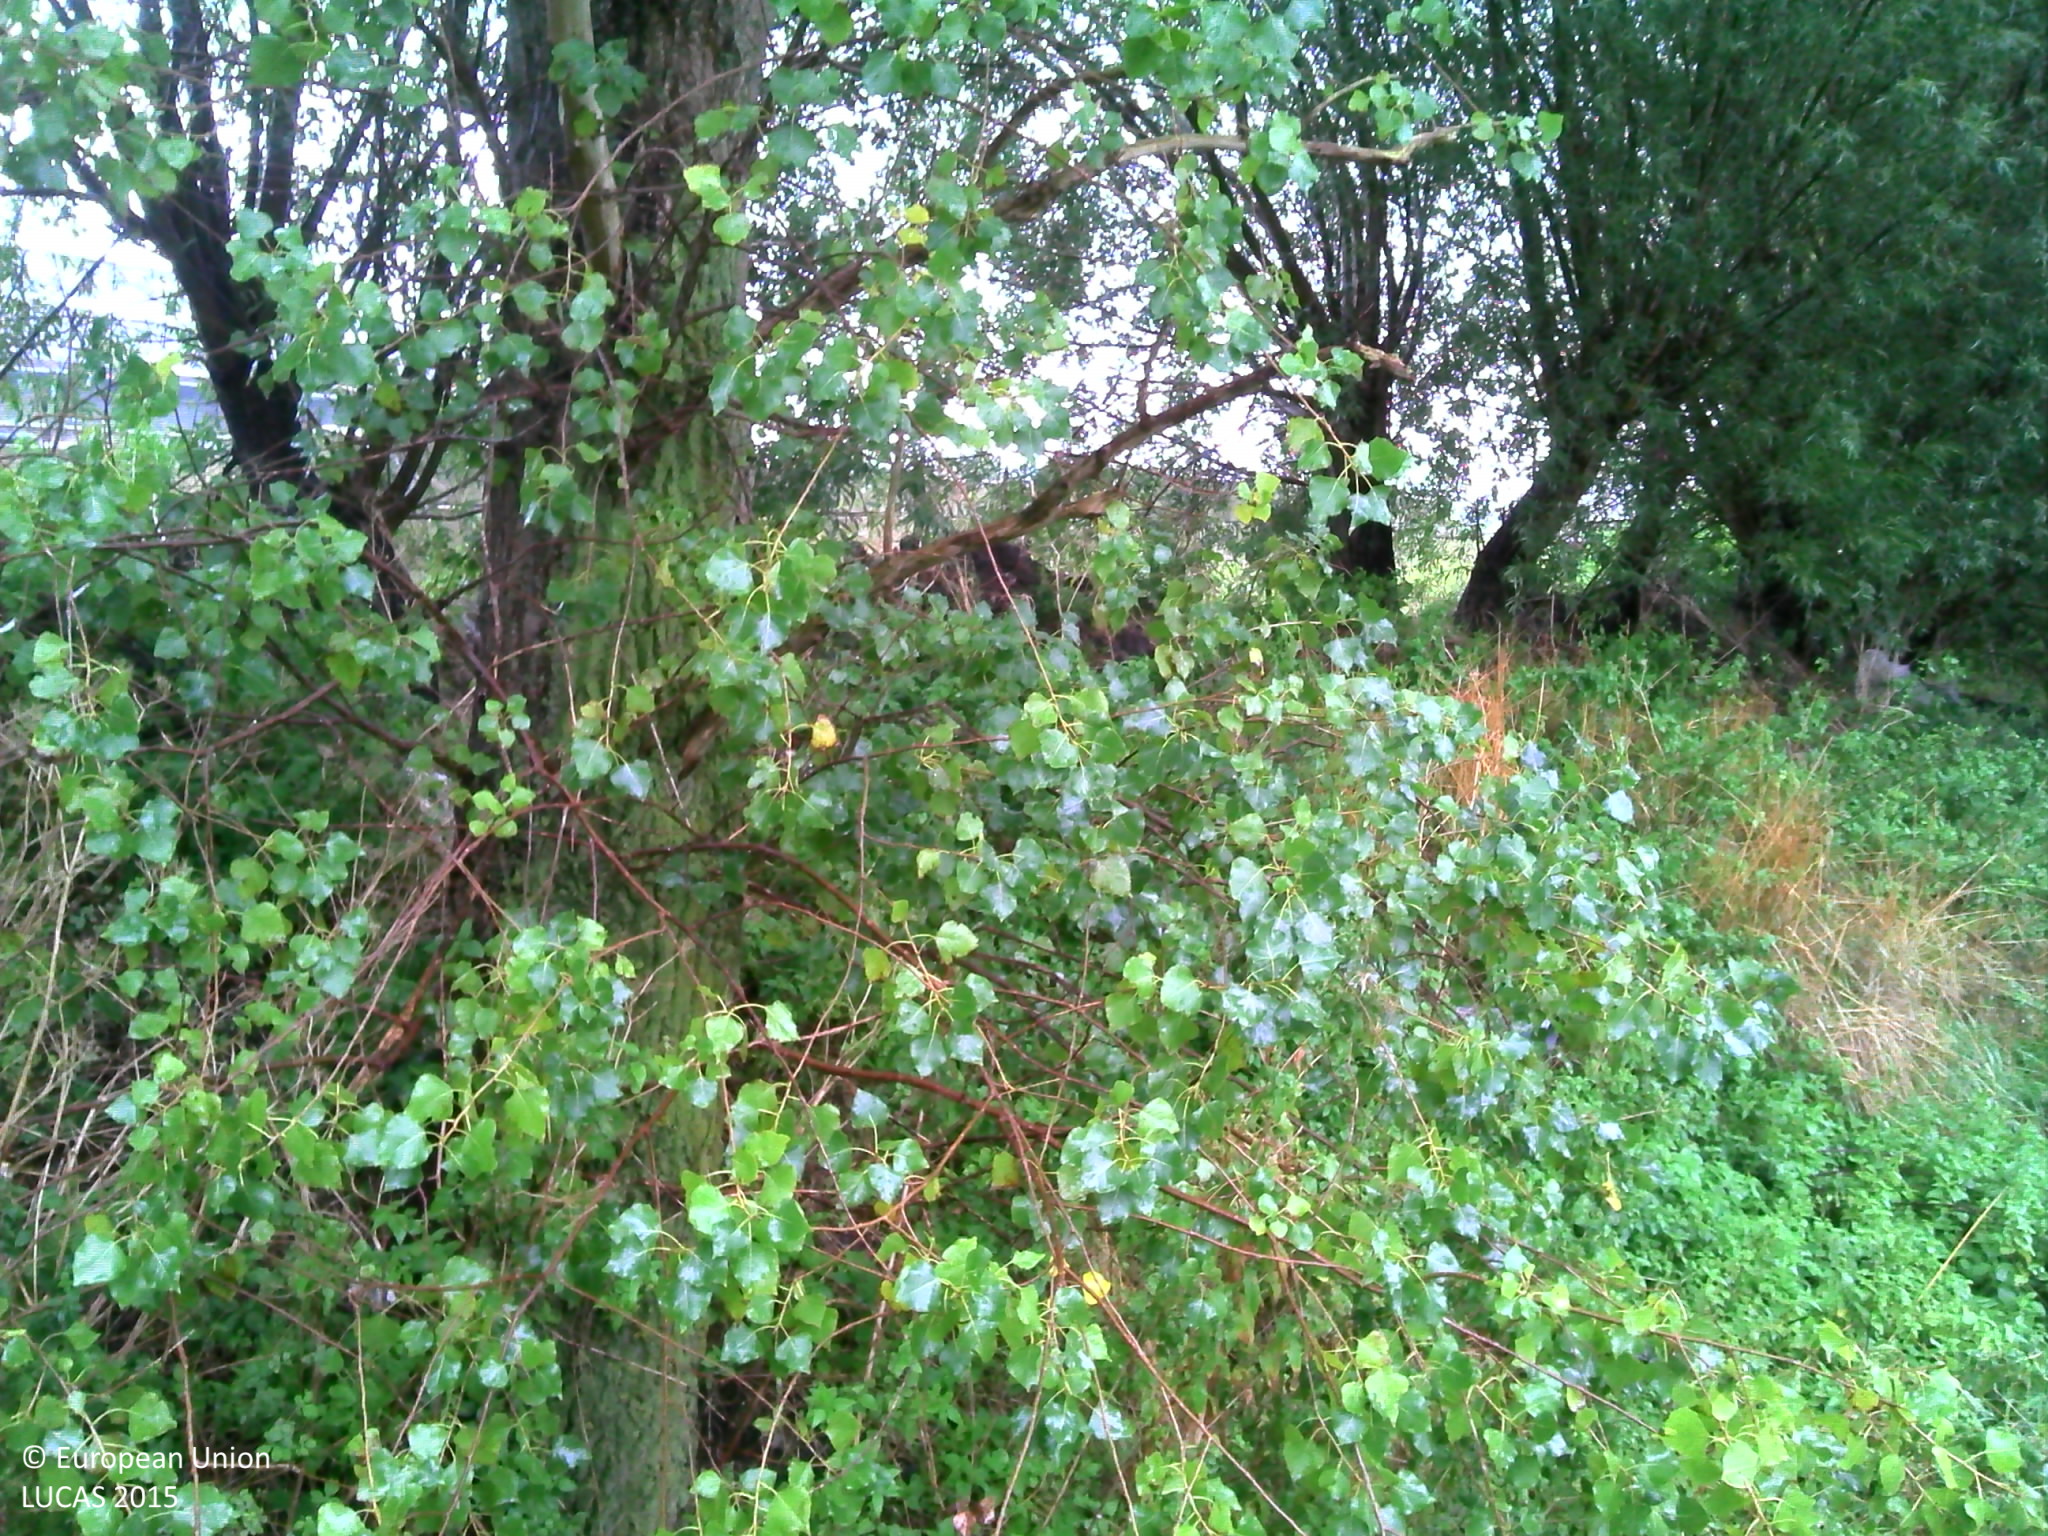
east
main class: Woodland
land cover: Broadleaved woodland
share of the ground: > 75 %
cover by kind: broadleaved forest trees 90 %, herbaceous plants 10 %
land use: Road transport
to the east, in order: Broadleaved woodland; Ditches and canals; Broadleaved woodland; Artificial constructions in urban areas; Grassland without tree/shrub cover; Fences; Grassland without tree/shrub cover; Fences; Shrubland without tree cover; Spontaneously vegetated surfaces; Fences; Grassland without tree/shrub cover
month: September
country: BE
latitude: 51.2189
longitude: 3.0750
